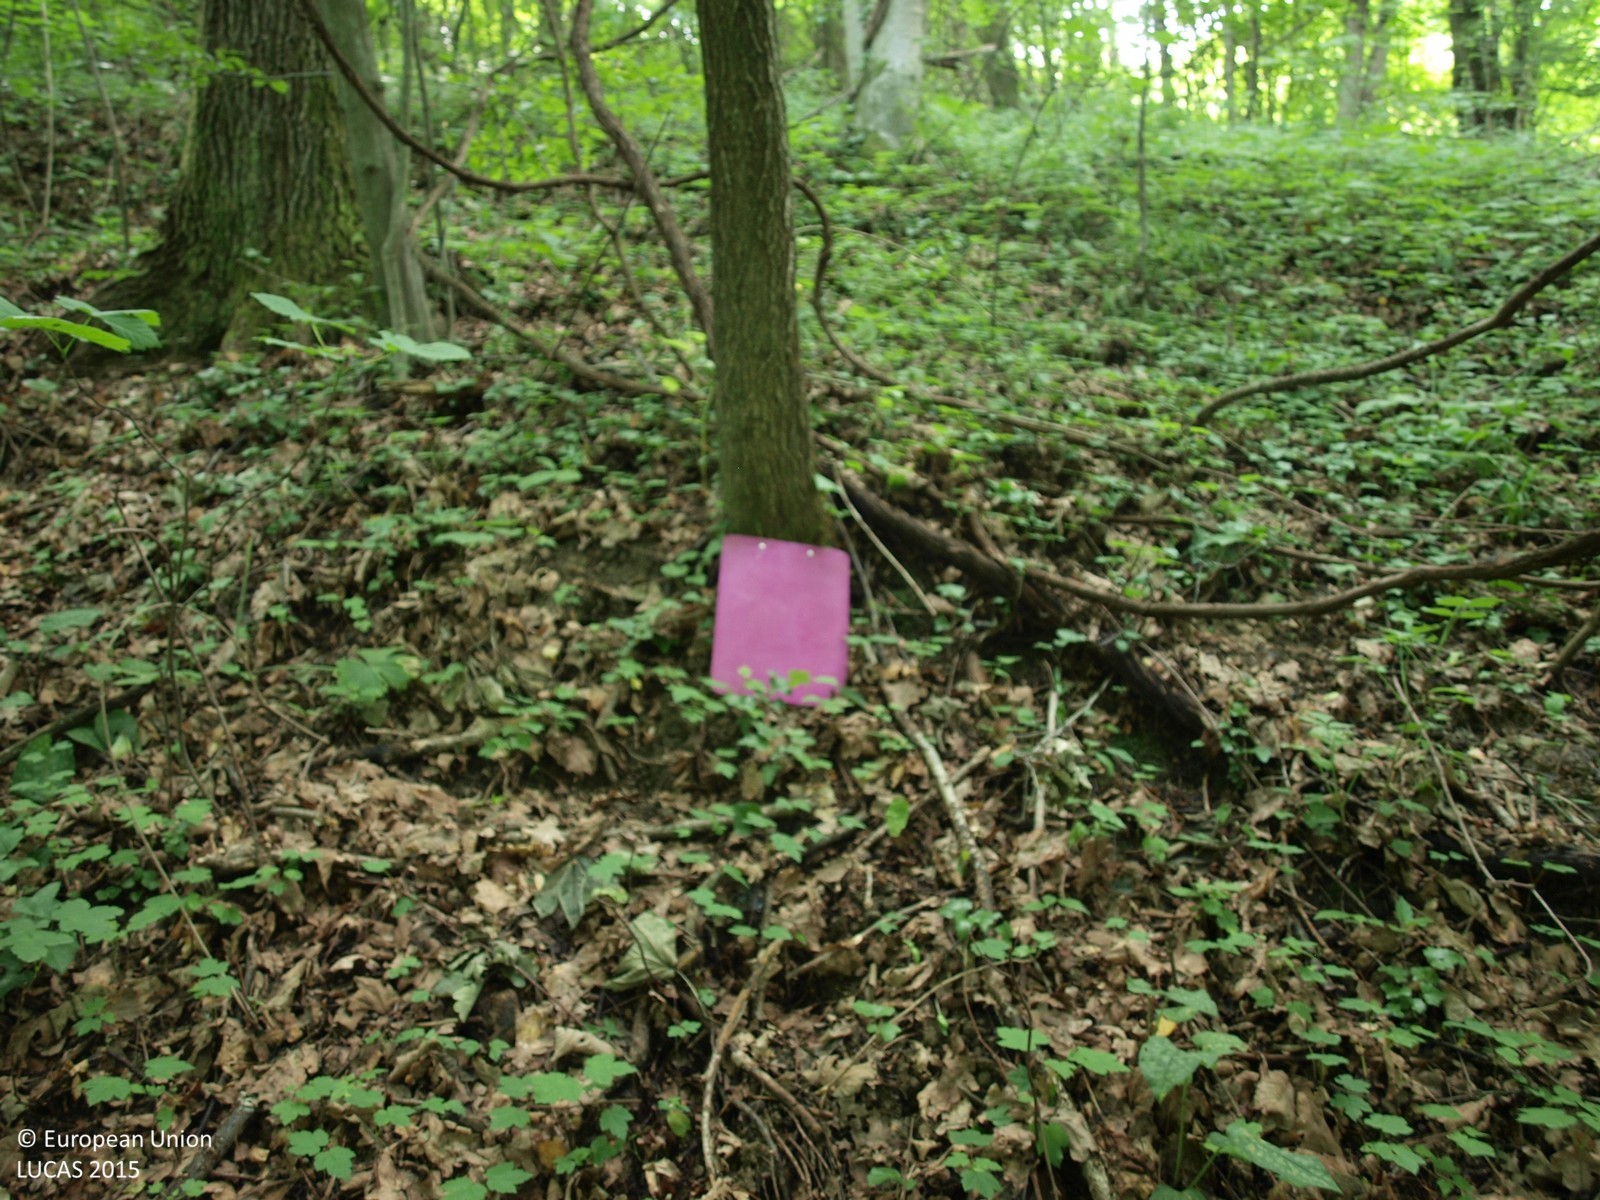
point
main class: Woodland
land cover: Broadleaved woodland
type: mesophytic deciduous forest
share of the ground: > 75 %
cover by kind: broadleaved forest trees 100 %
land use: Forestry
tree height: > 5 m
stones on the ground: < 10 %
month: June
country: HR
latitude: 46.1281
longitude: 15.6798
